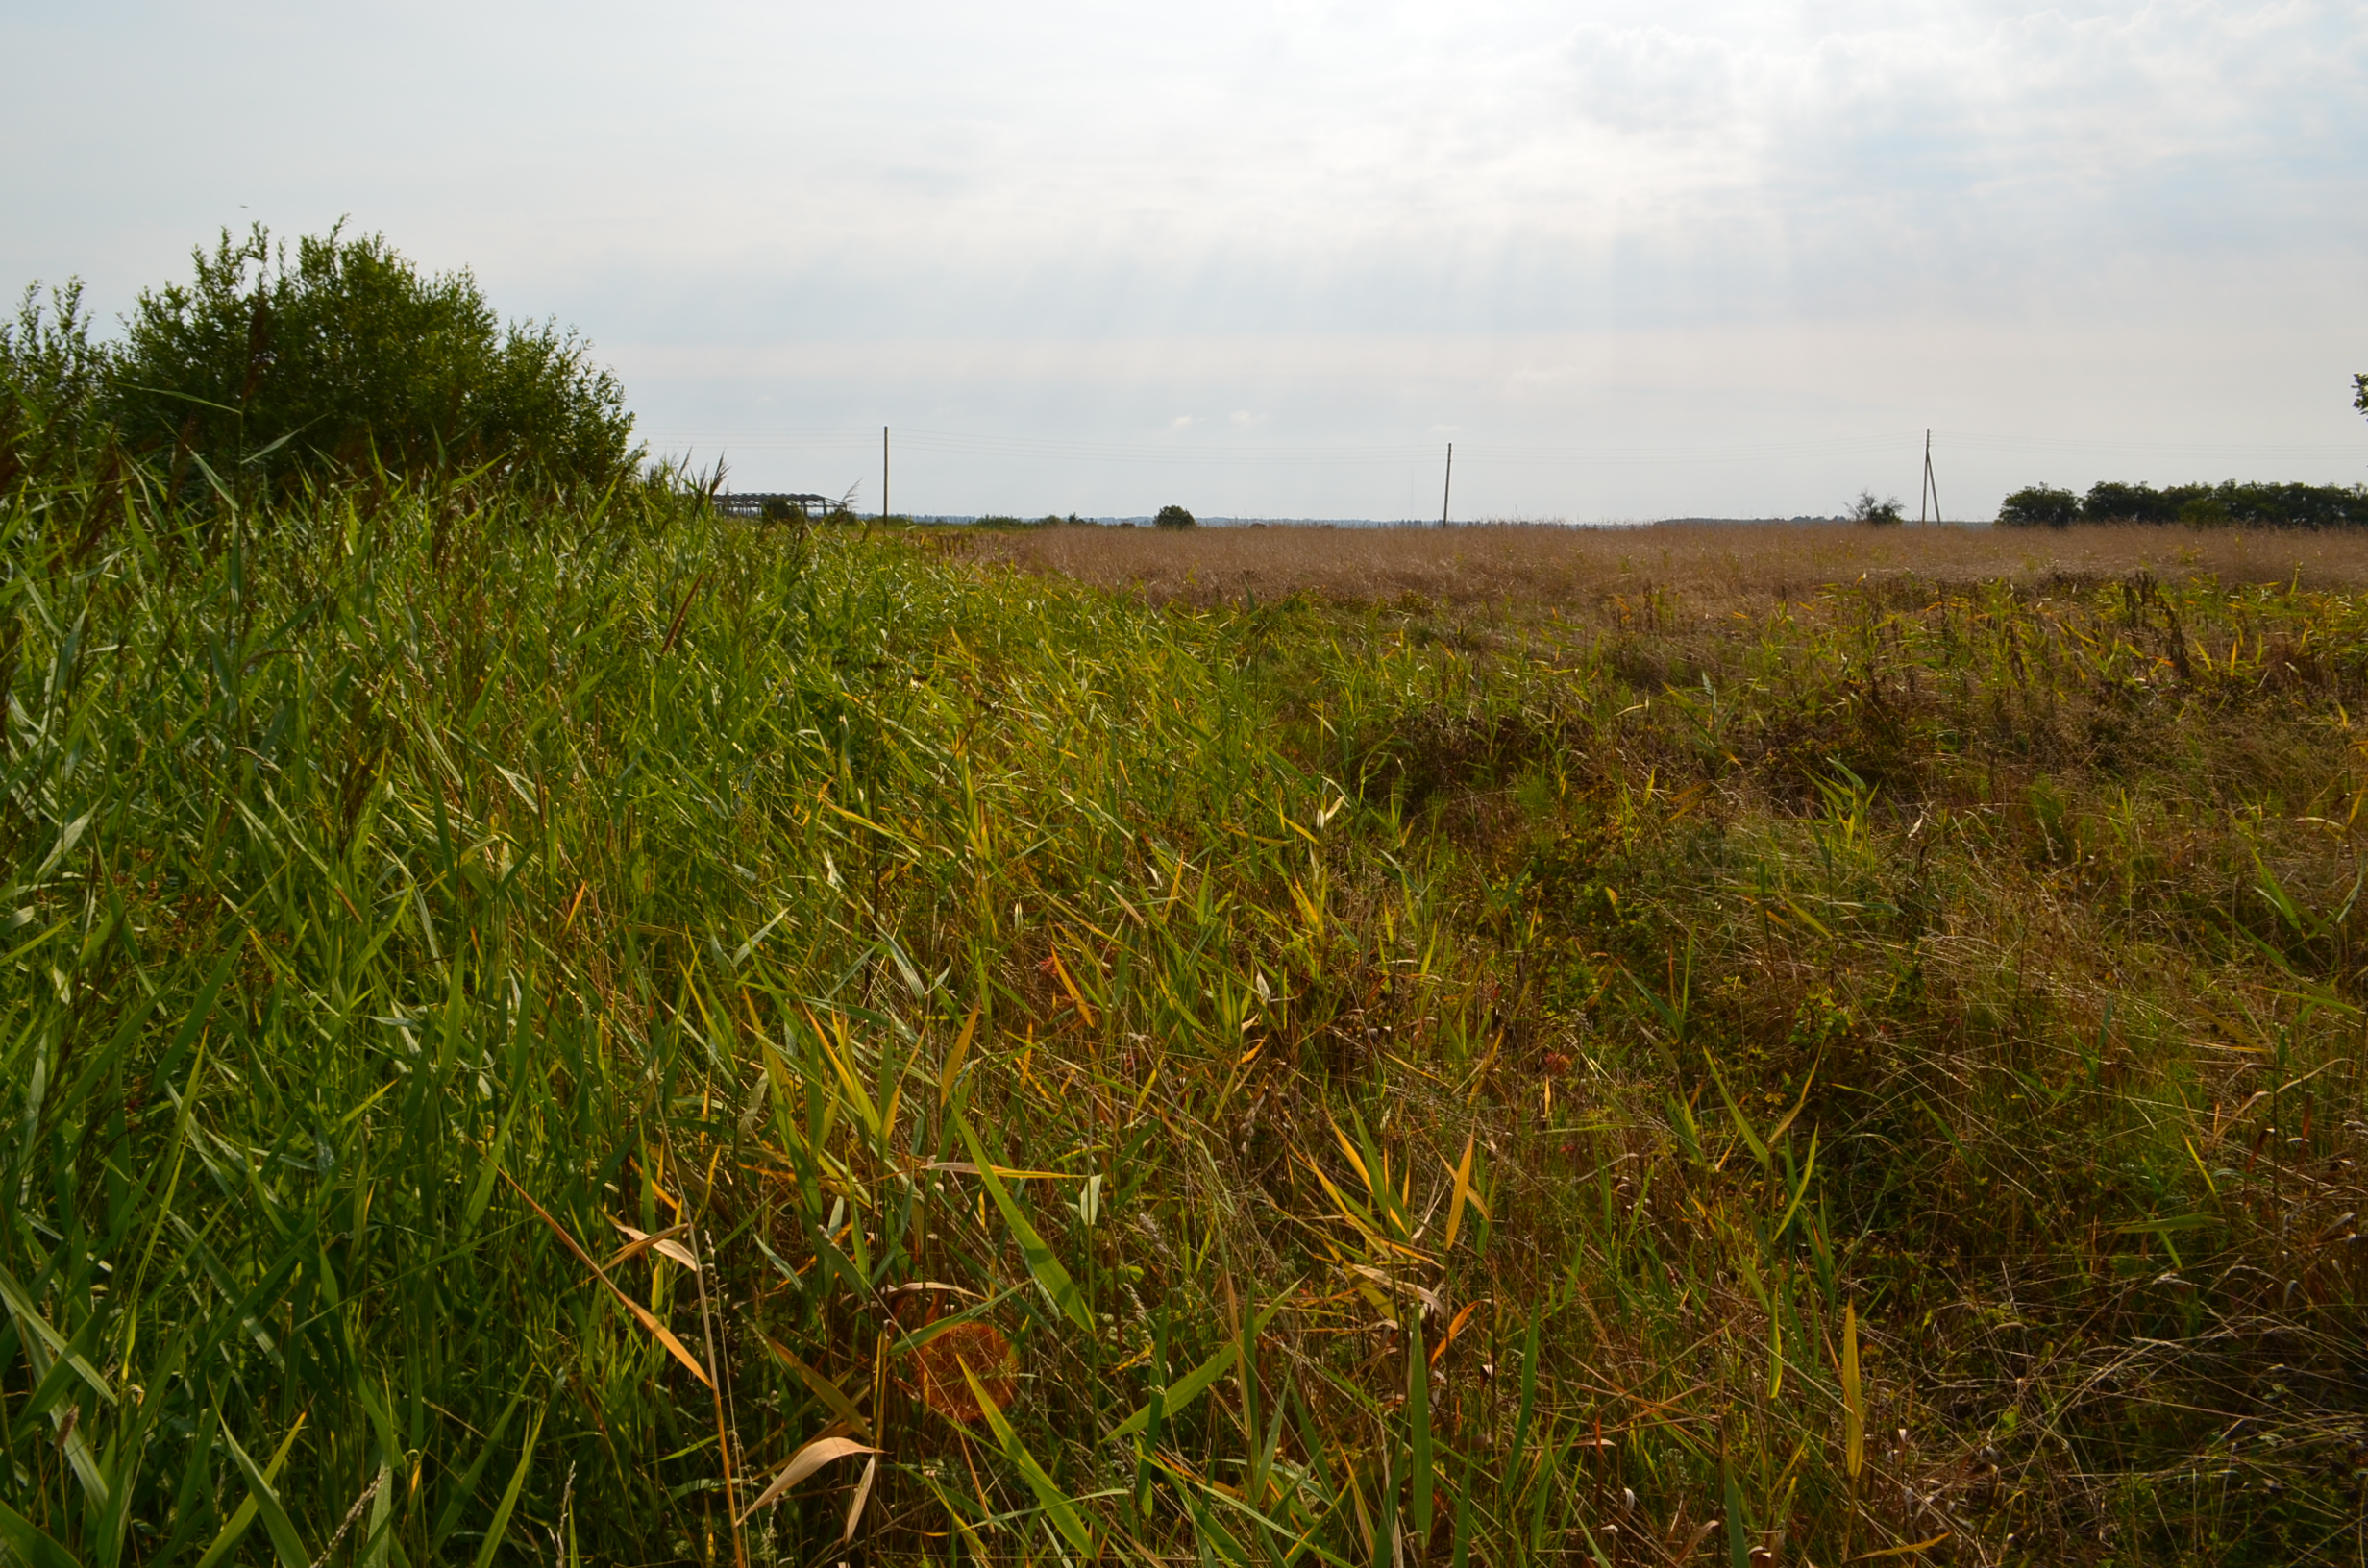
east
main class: Grassland
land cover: Spontaneously vegetated surfaces
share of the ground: > 75 %
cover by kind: herbaceous plants 95 %, shrubs 5 %
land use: Semi-natural and natural areas not in use
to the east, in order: Spontaneously vegetated surfaces; Grassland without tree/shrub cover; Electric lines; Ditches and canals; Grass margins; Paved roads, cycling and walking lanes; Grassland without tree/shrub cover; Ditches and canals; Spontaneously vegetated surfaces
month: August
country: LV
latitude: 57.3492
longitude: 21.6236
